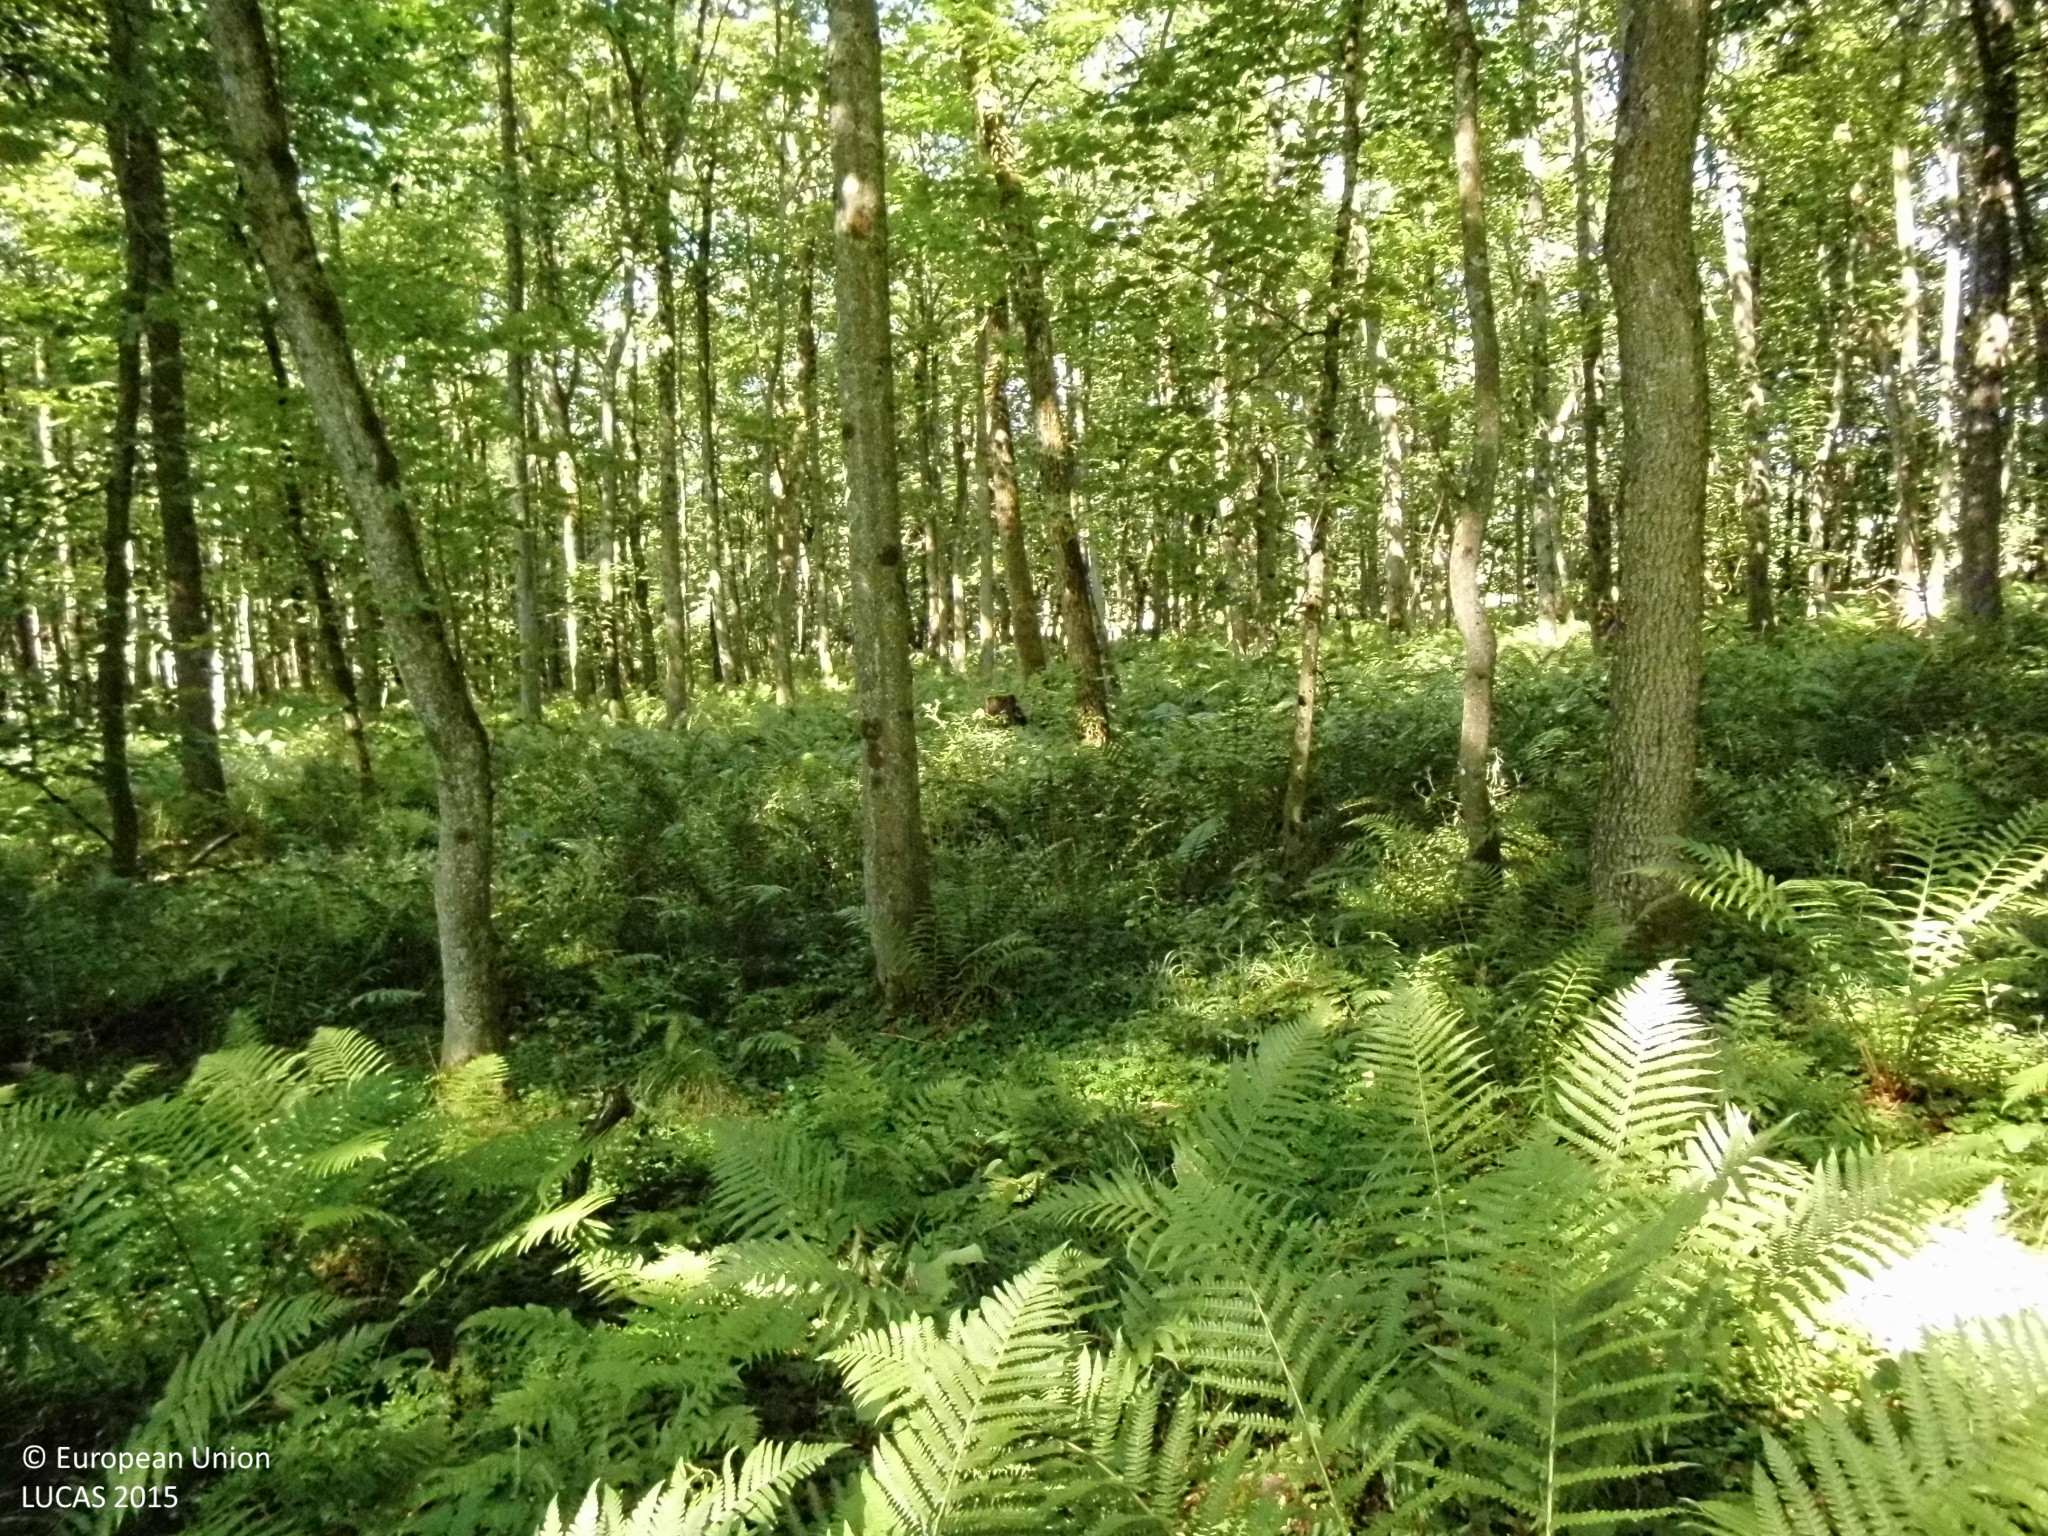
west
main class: Woodland
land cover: Broadleaved woodland
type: mesophytic deciduous forest
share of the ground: > 75 %
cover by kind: broadleaved forest trees 80 %, herbaceous plants 20 %
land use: Forestry
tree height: > 5 m
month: August
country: DE
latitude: 50.6539
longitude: 8.0909
